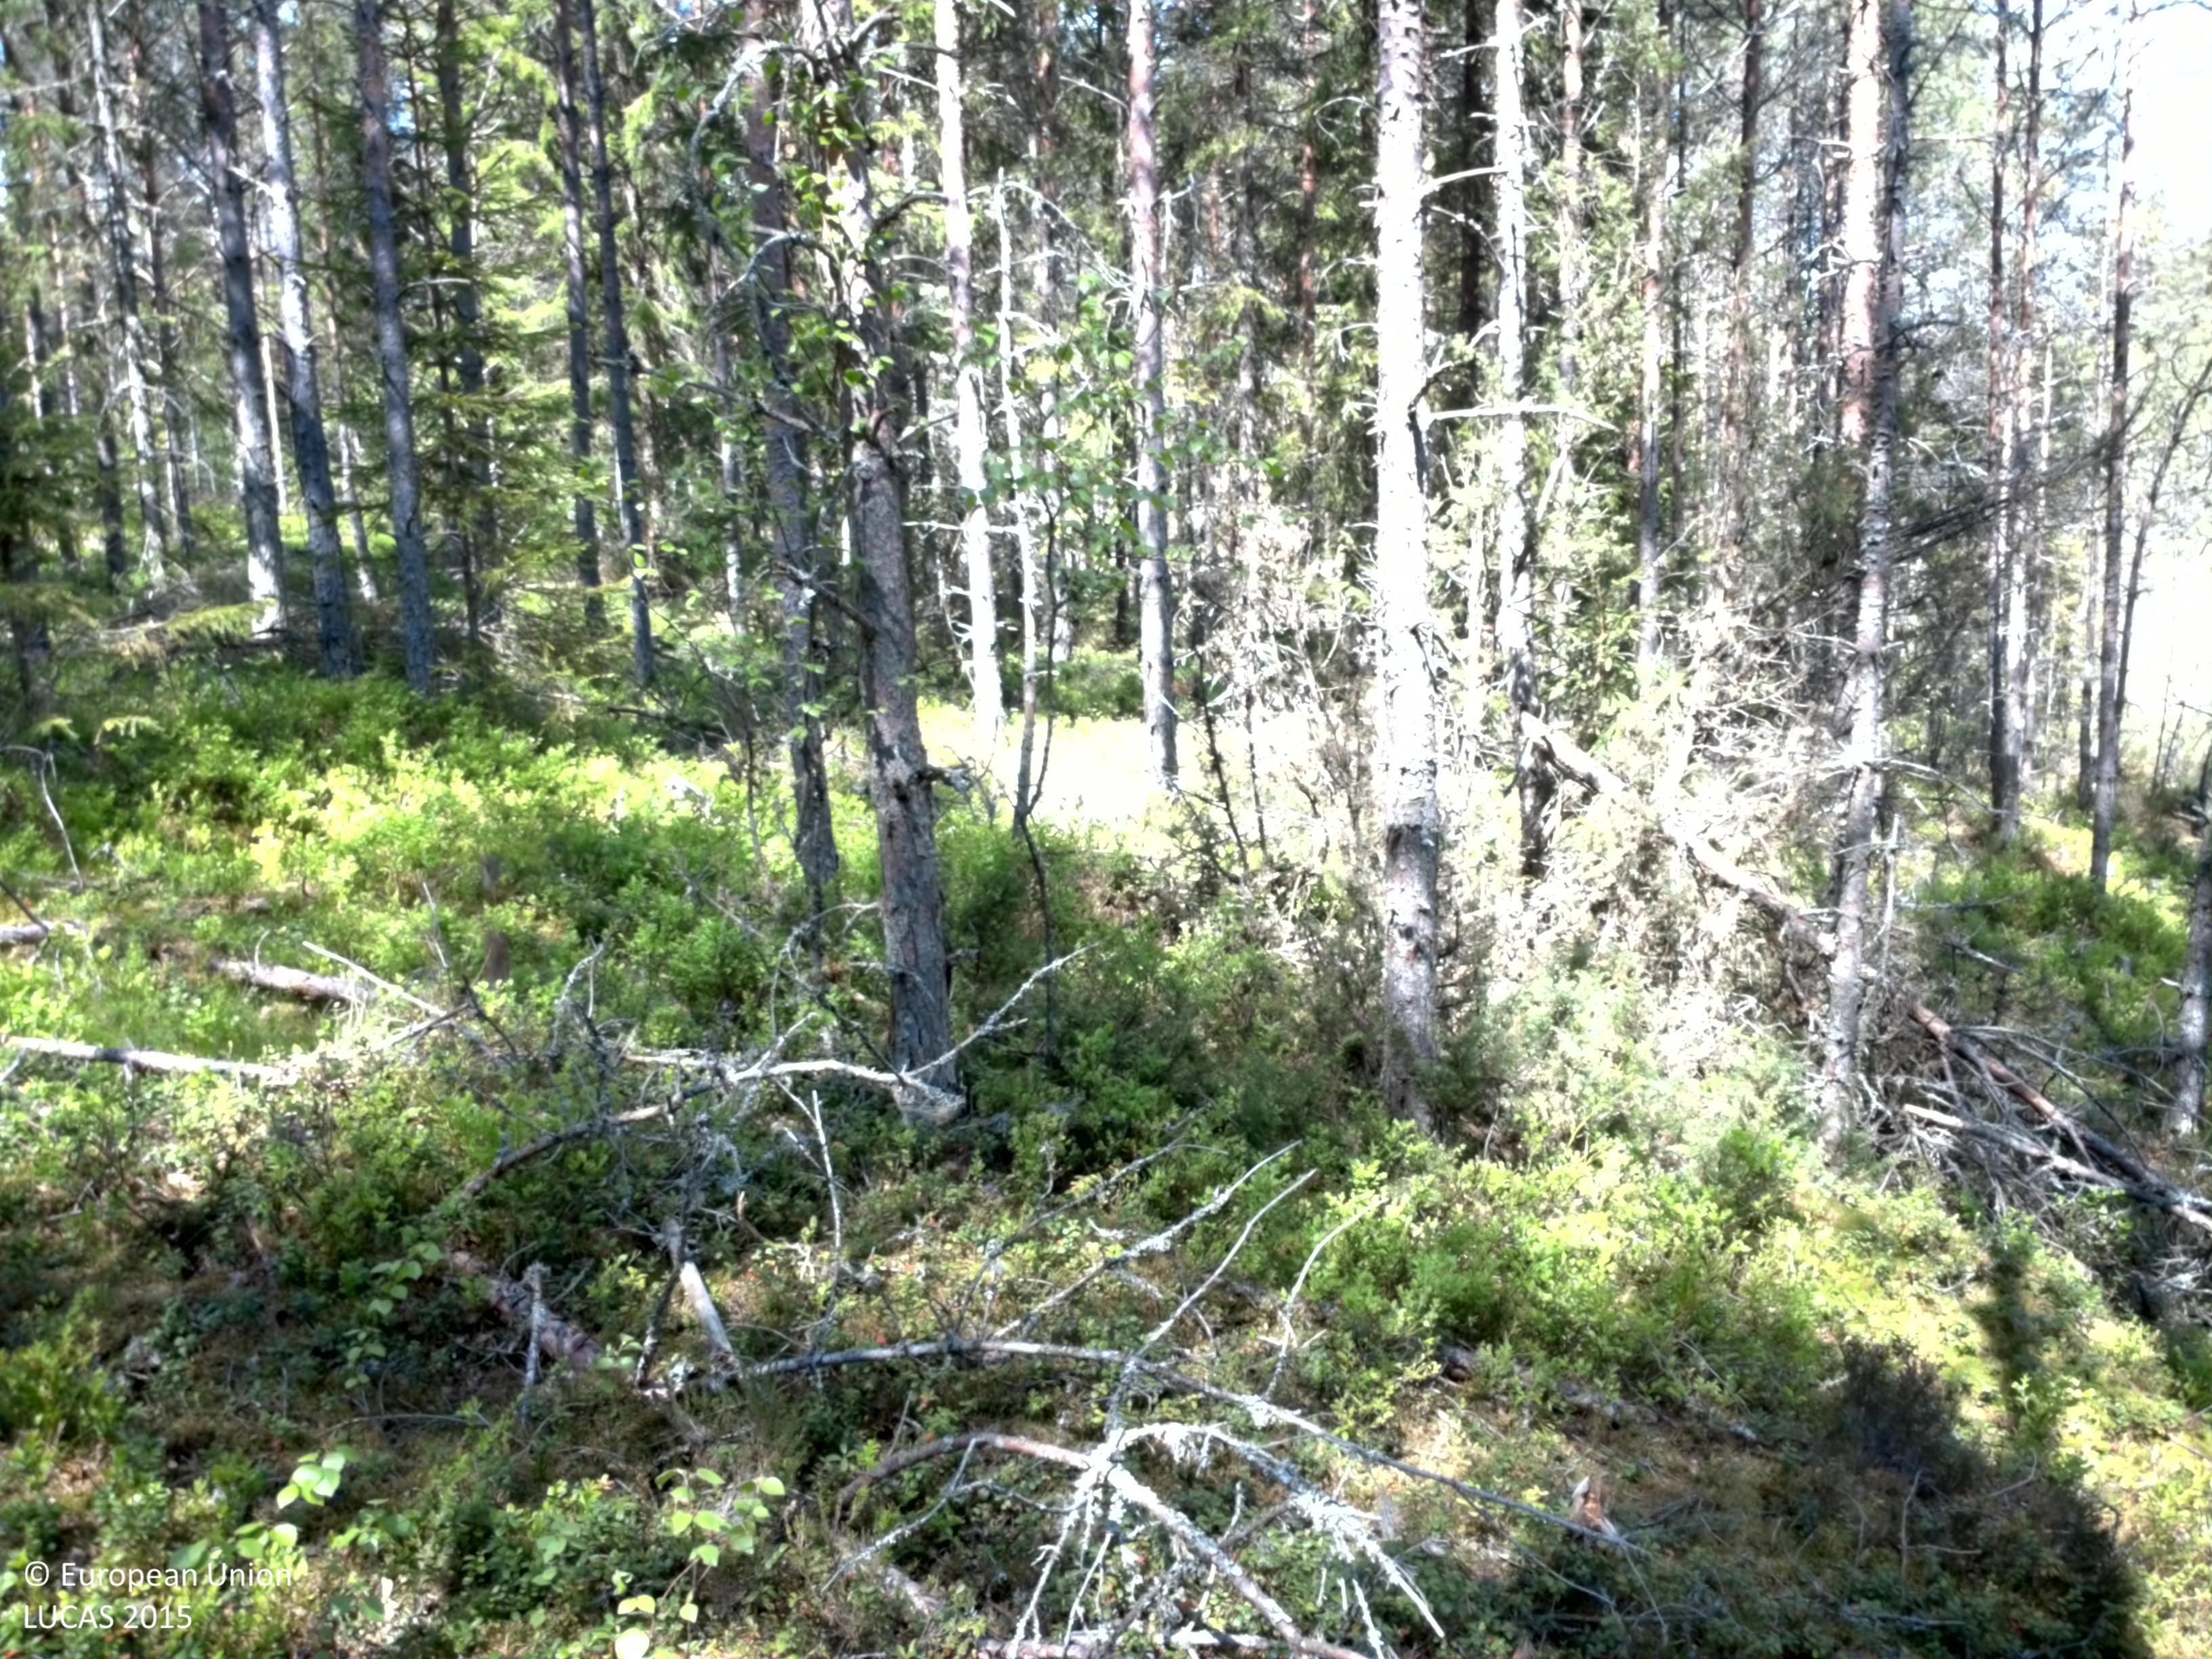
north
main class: Woodland
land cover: Pine dominated coniferous woodland
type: boreal forest
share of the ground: > 75 %
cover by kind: coniferous forest trees 80 %, shrubs 10 %, lichens and mosses 10 %
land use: Forestry
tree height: > 5 m
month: June
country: SE
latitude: 59.3679
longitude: 12.4046
